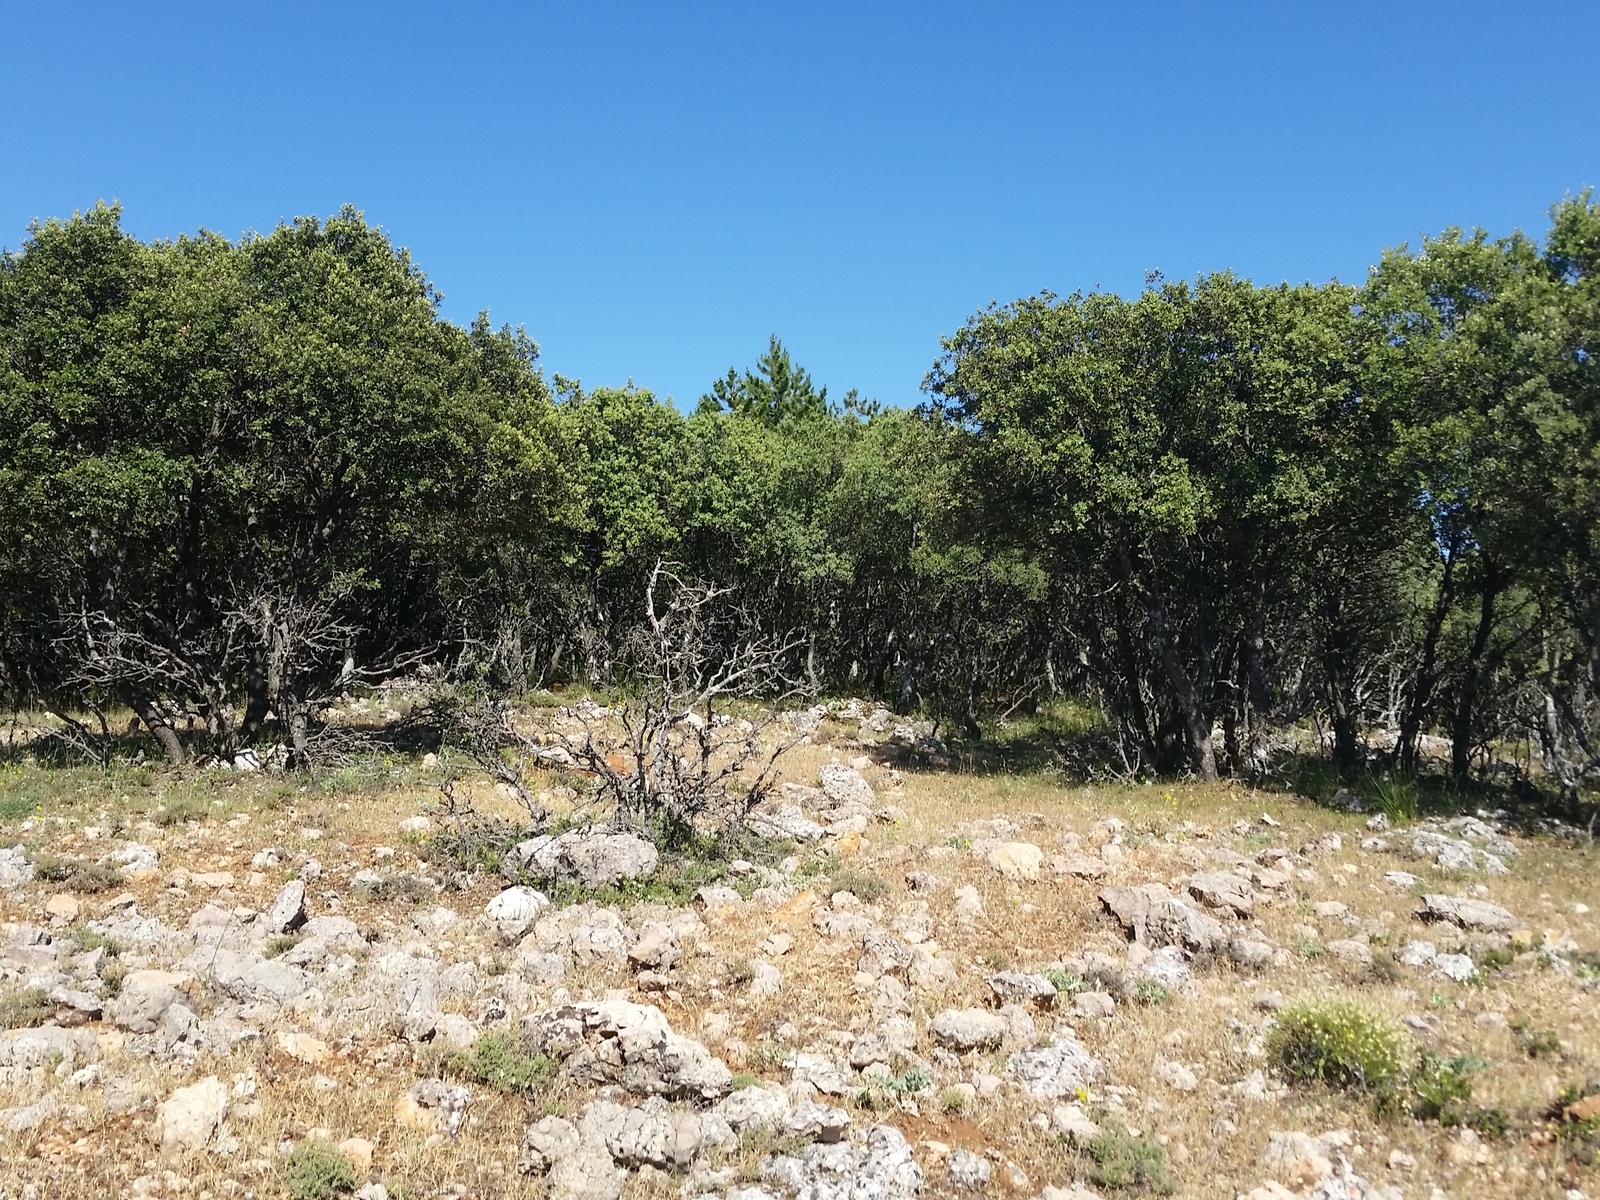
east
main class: Woodland
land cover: Pine dominated coniferous woodland
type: coniferous forest of the mediterranean region
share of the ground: 50 - 75 %
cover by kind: coniferous forest trees 60 %, shrubs 30 %, herbaceous plants 5 %, consolidated bare surface 5 %
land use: Semi-natural and natural areas not in use
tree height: > 5 m
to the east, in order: Pine dominated coniferous woodland
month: June
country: ES
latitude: 38.5414
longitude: -2.5630
